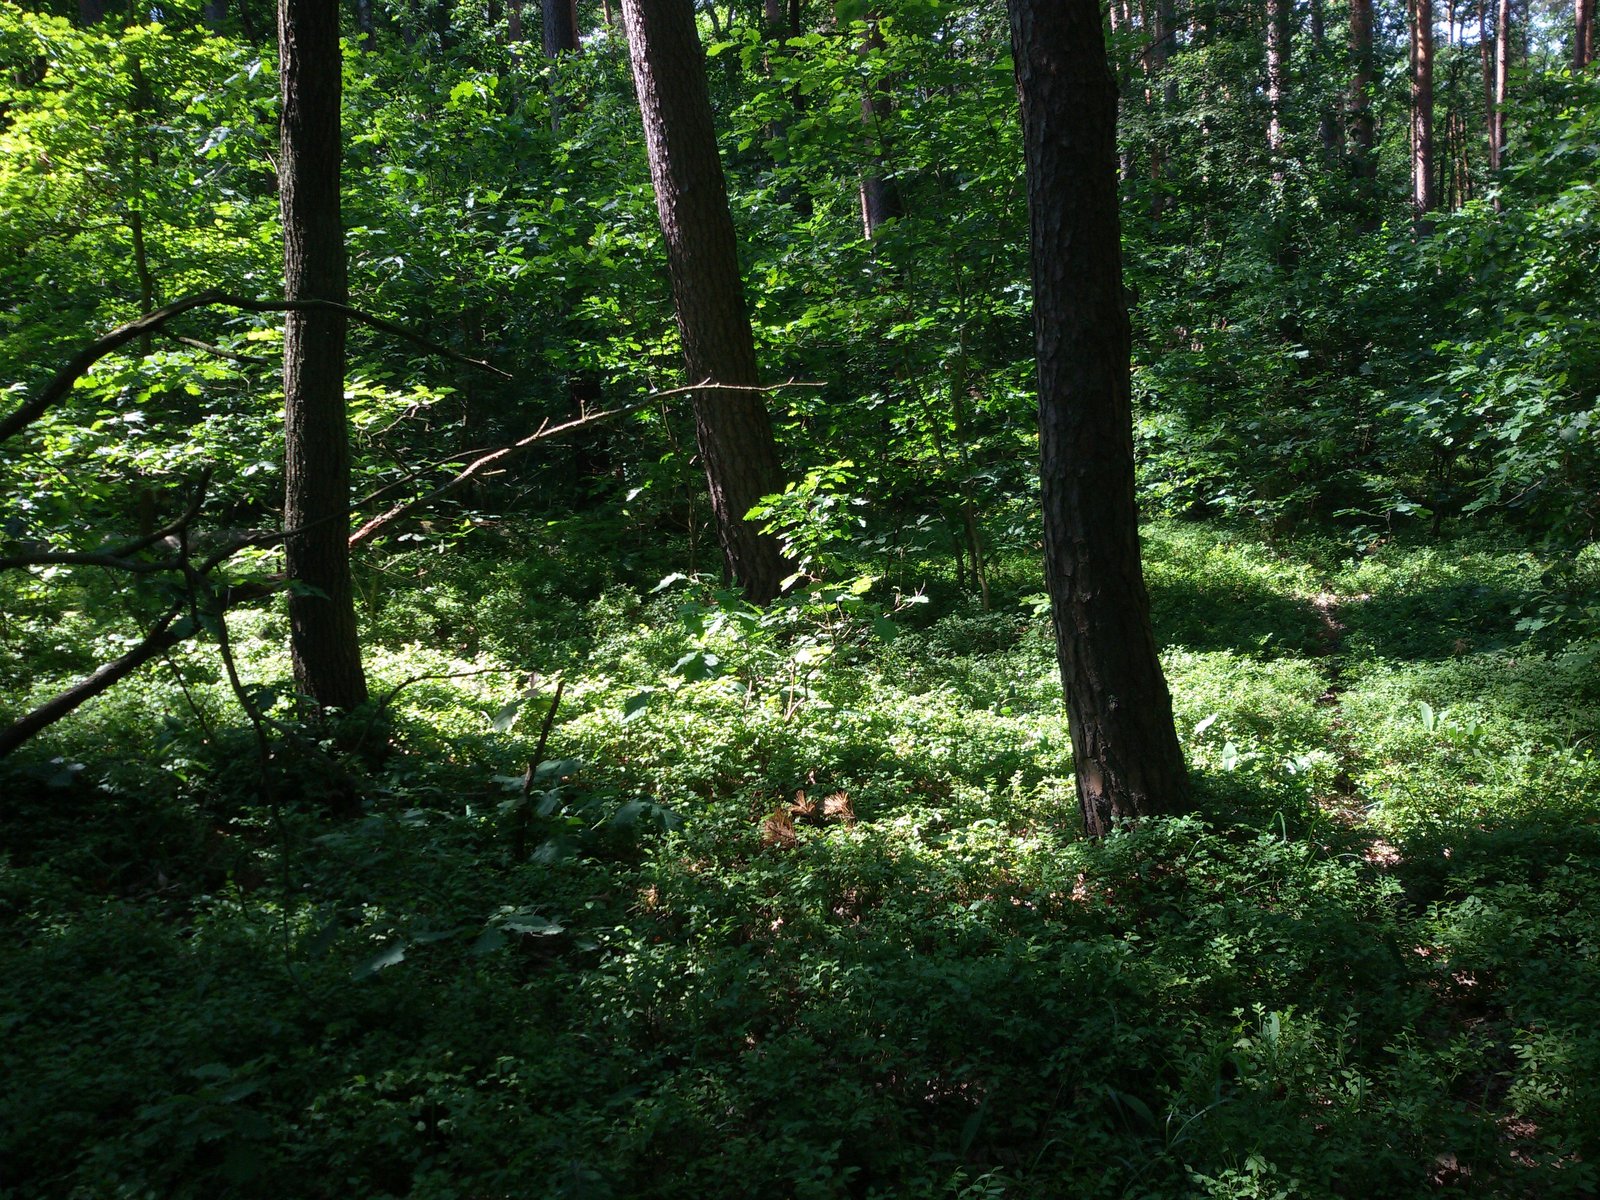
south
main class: Woodland
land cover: Pine dominated mixed woodland
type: hemiboreal forest and nemoral coniferous forest and mixed broadleaved-coniferous forest
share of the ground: > 75 %
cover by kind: coniferous forest trees 60 %, broadleaved forest trees 30 %, herbaceous plants 10 %
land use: Forestry
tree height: > 5 m
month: June
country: PL
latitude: 52.1555
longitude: 16.9526
